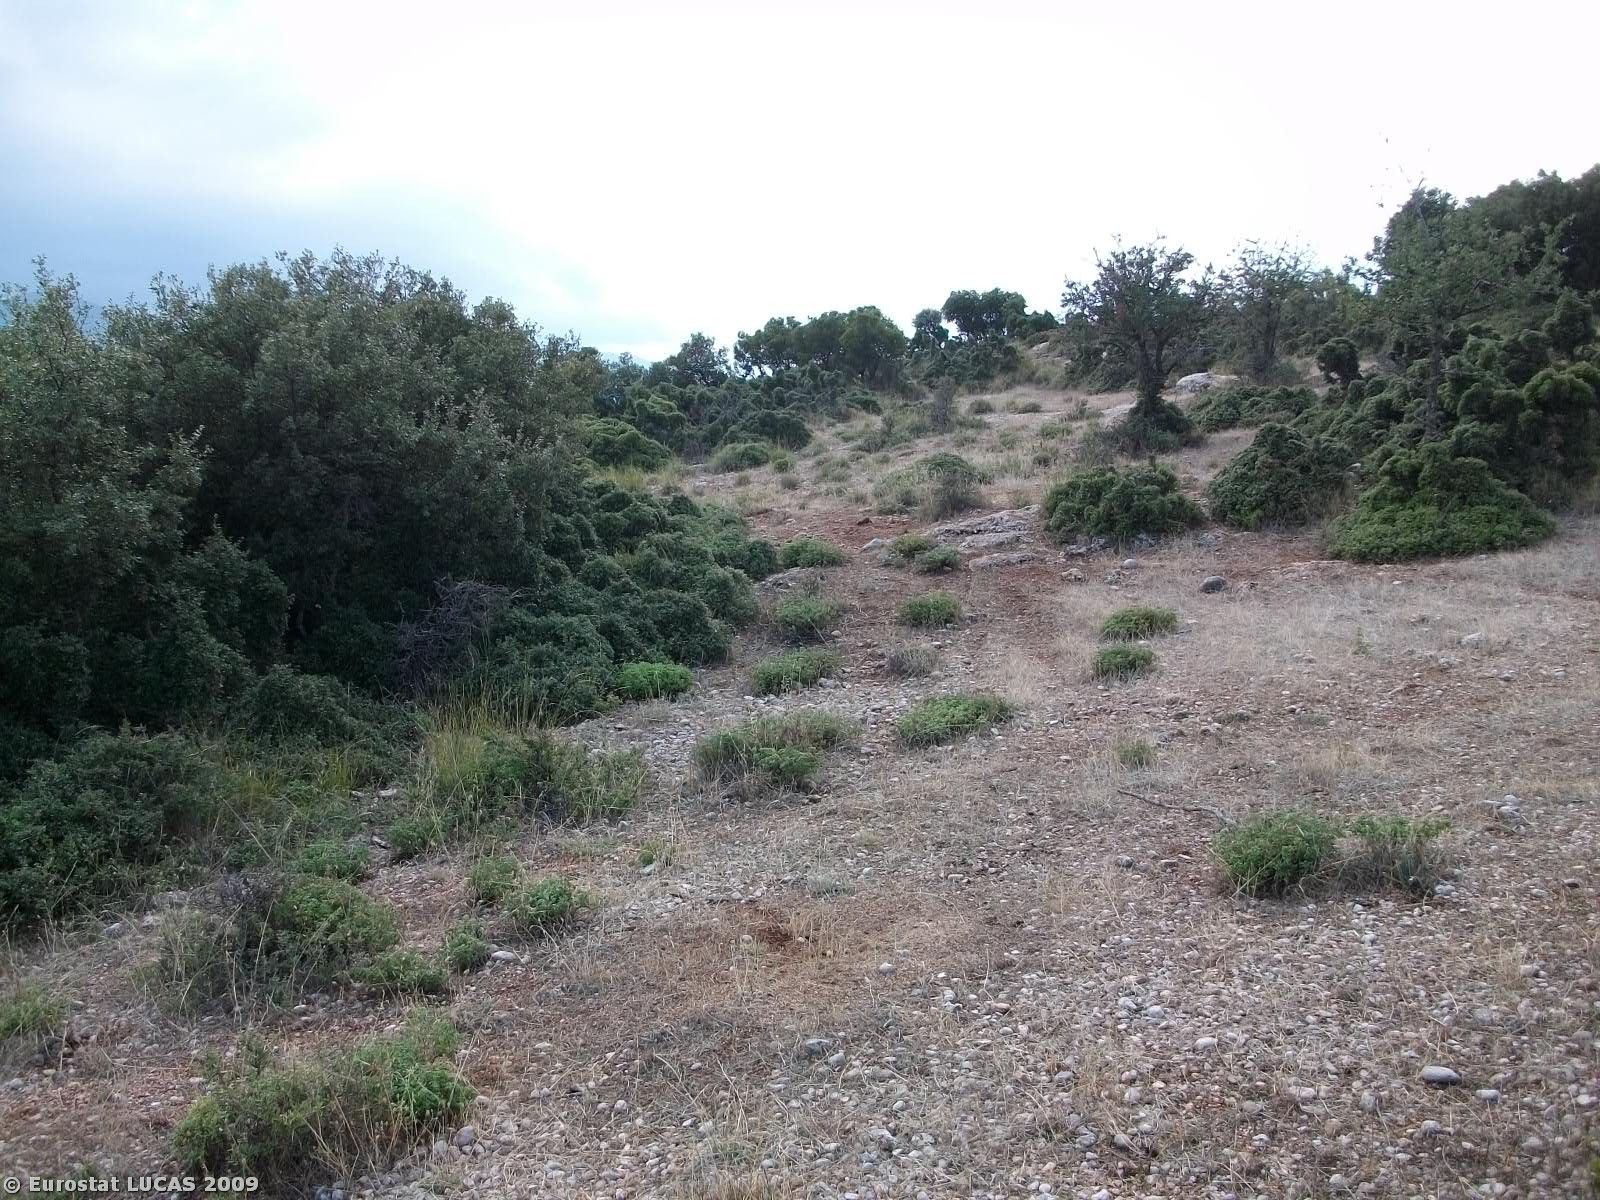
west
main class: Grassland
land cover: Grassland with sparse tree/shrub cover
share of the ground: > 75 %
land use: Agriculture (excluding fallow land and kitchen gardens)
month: September
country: GR
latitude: 37.8504
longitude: 22.5258
